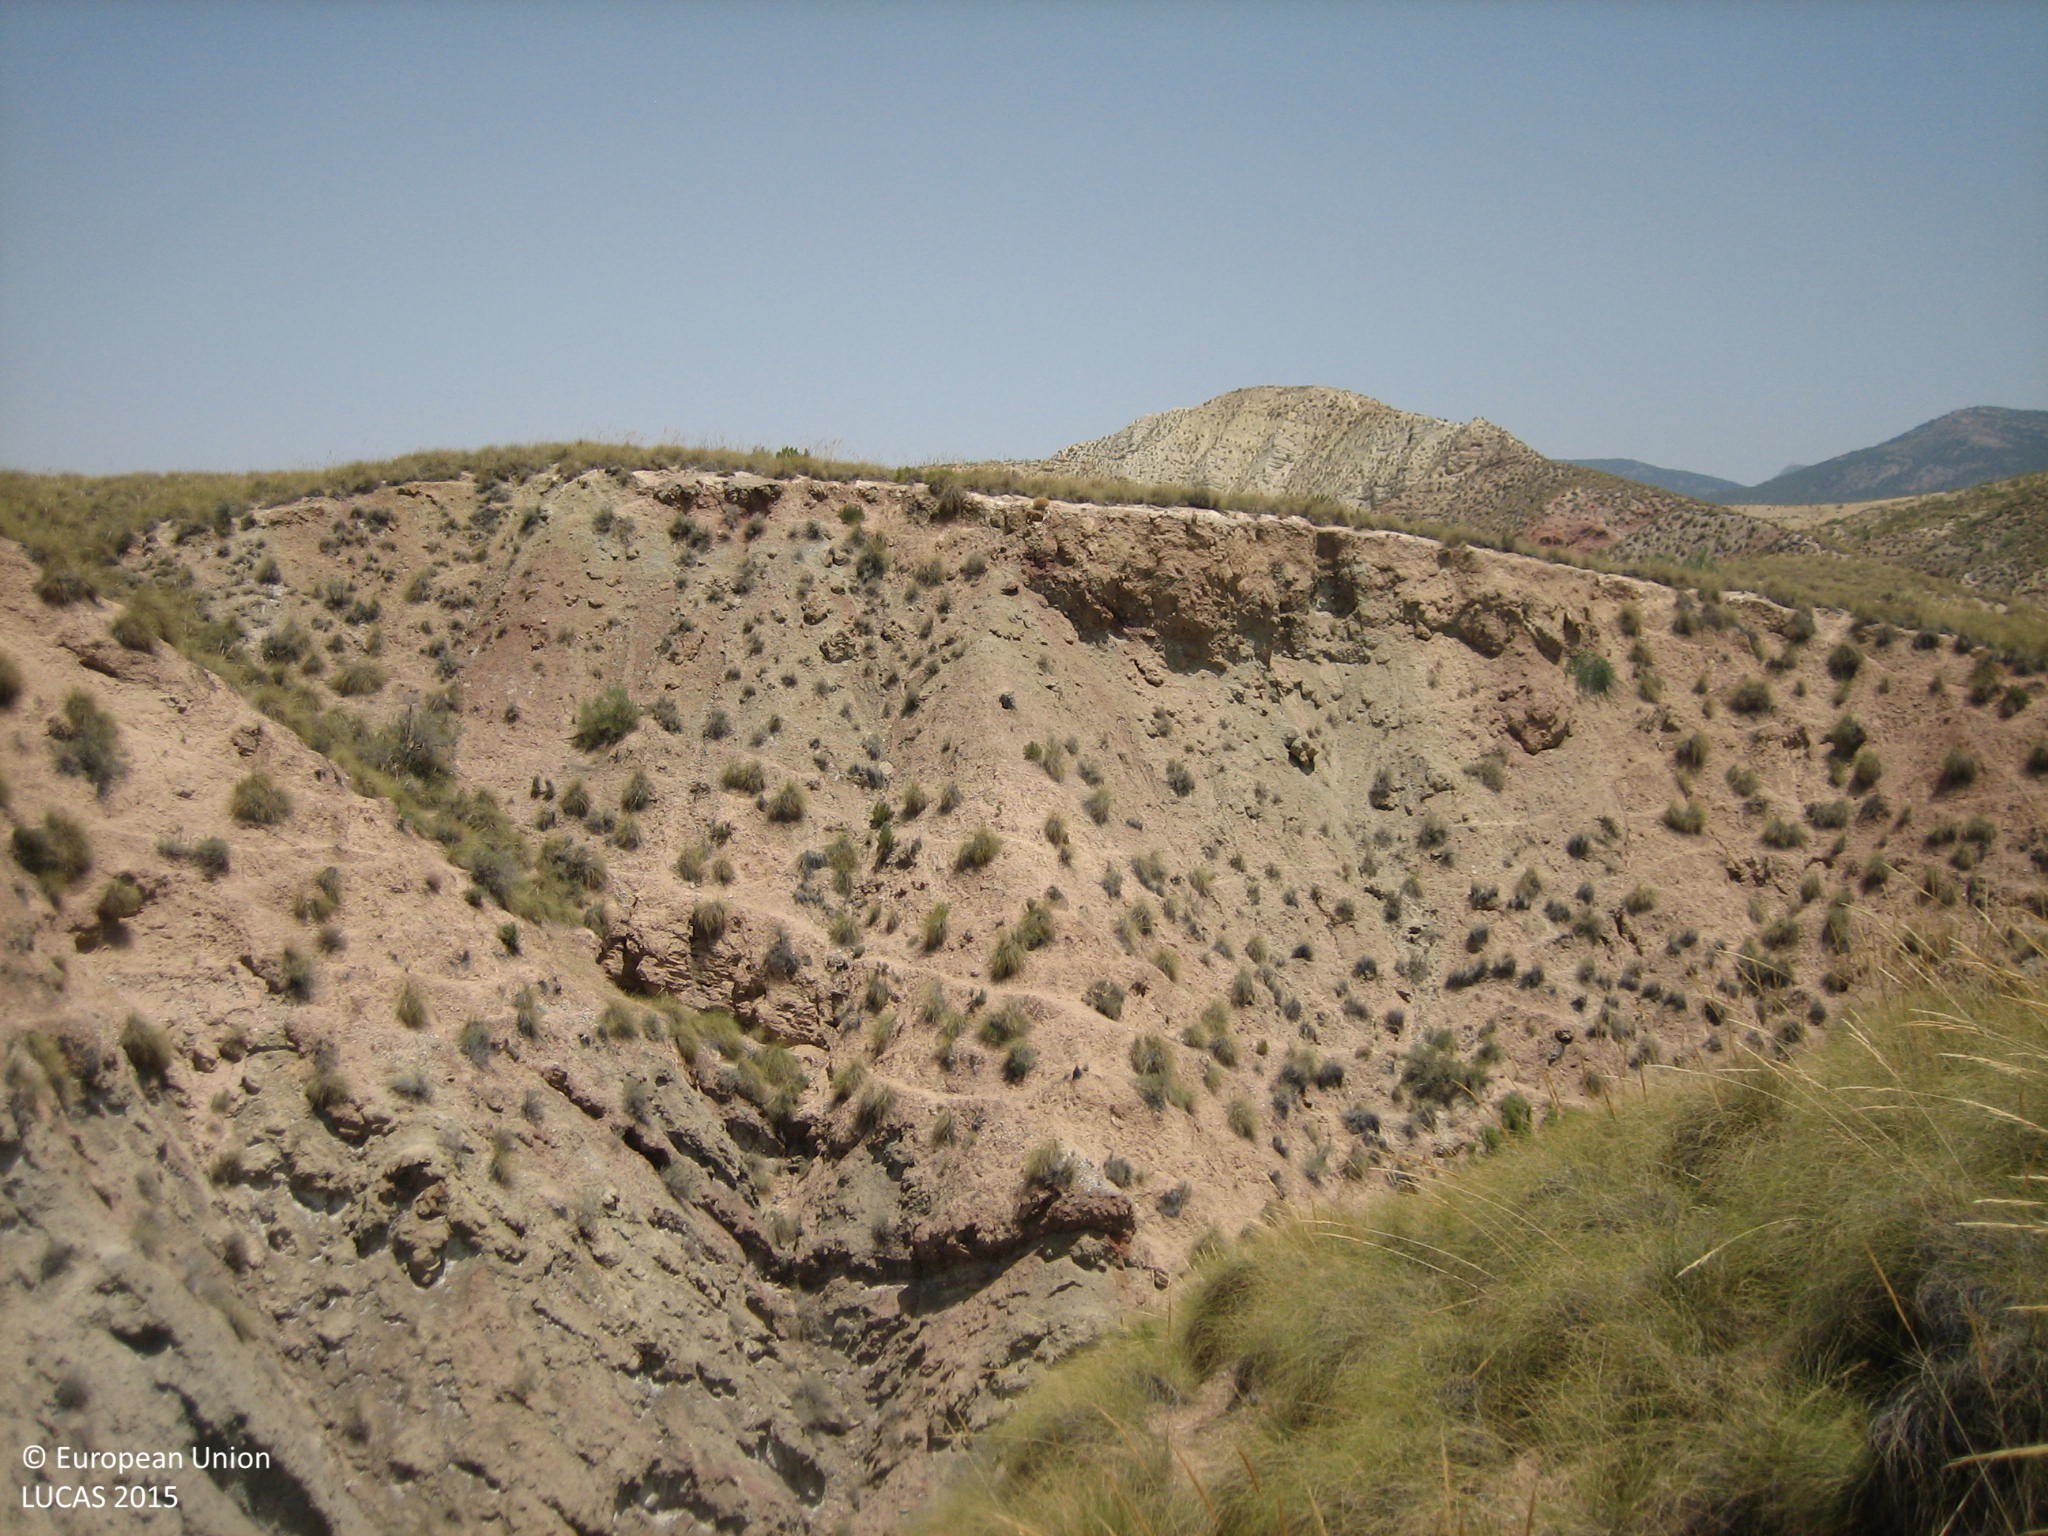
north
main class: Grassland
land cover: Grassland without tree/shrub cover
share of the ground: > 75 %
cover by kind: herbaceous plants 80 %, consolidated bare surface 20 %
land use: Agriculture (excluding fallow land and kitchen gardens)
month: July
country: ES
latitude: 37.6917
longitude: -3.0224
